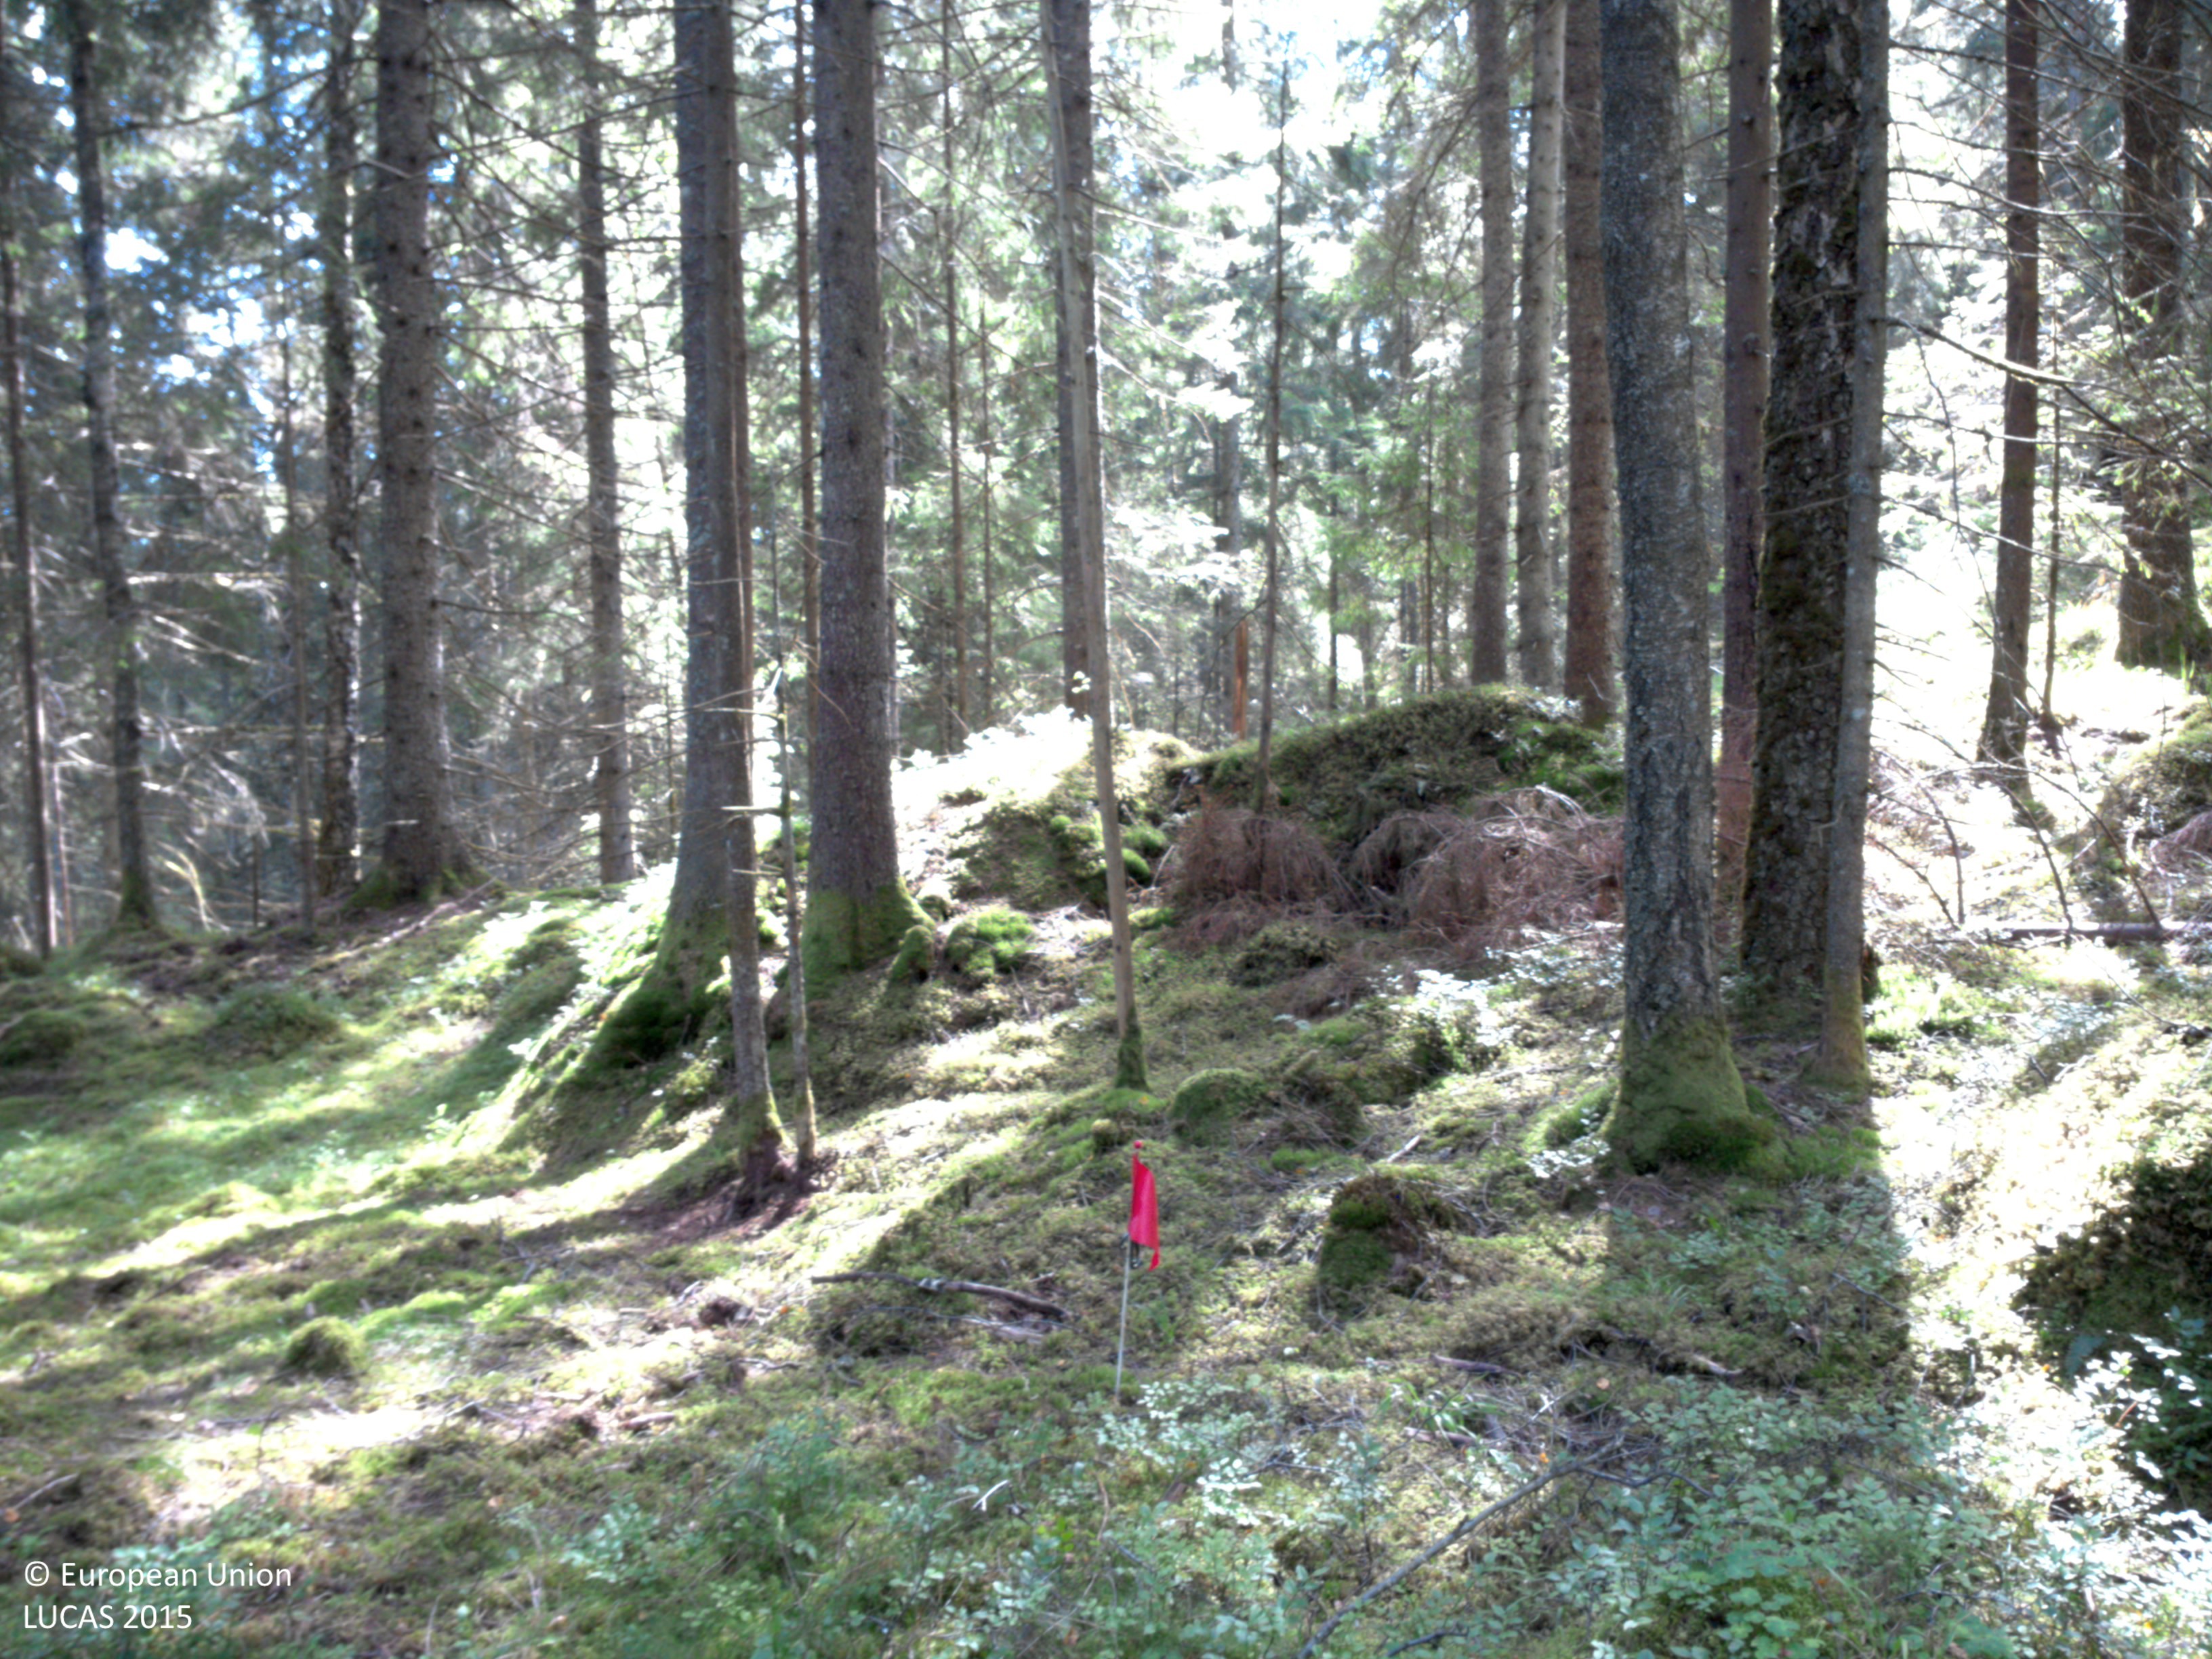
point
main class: Woodland
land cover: Spruce dominated coniferous woodland
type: boreal forest
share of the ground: 50 - 75 %
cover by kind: coniferous forest trees 60 %, lichens and mosses 30 %, shrubs 10 %
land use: Forestry
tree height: > 5 m
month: August
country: SE
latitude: 58.0017
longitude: 12.3140
